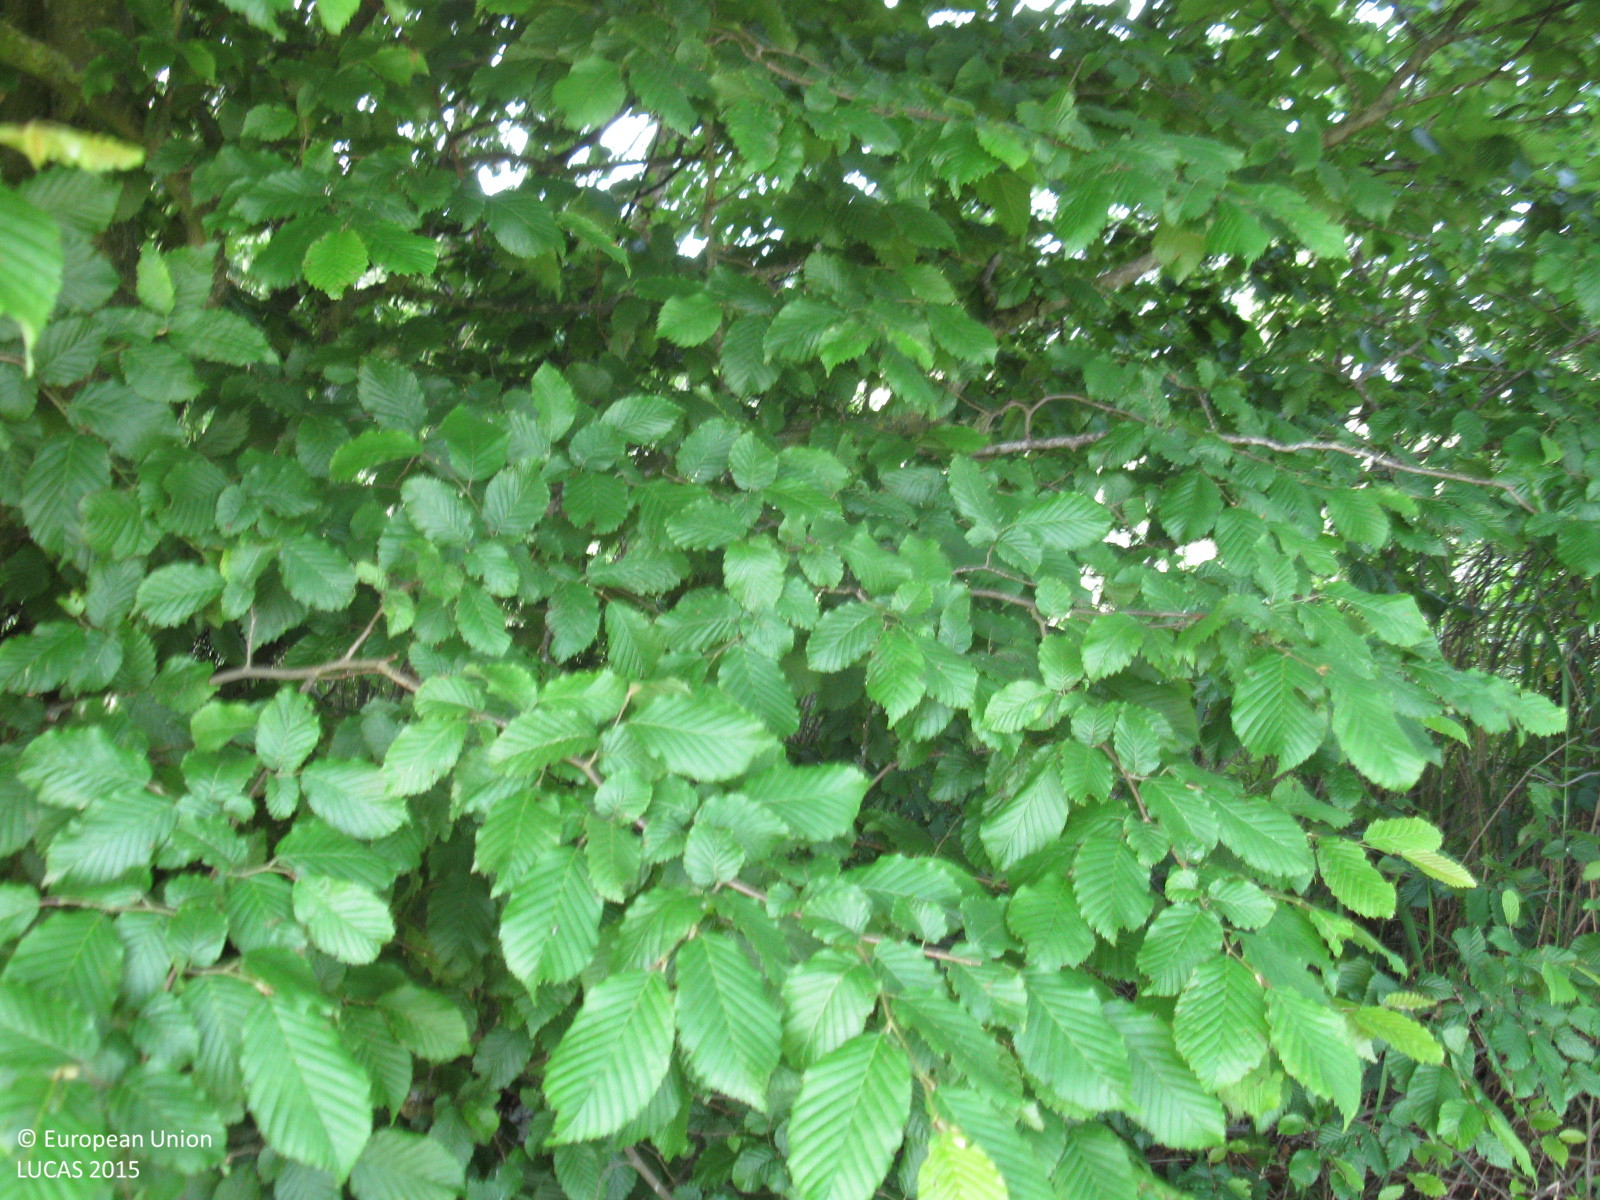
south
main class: Woodland
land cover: Broadleaved woodland
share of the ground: > 75 %
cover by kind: broadleaved forest trees 100 %
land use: Commerce
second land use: Amenities, museums, leisure
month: June
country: DE
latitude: 53.4439
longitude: 7.3057
